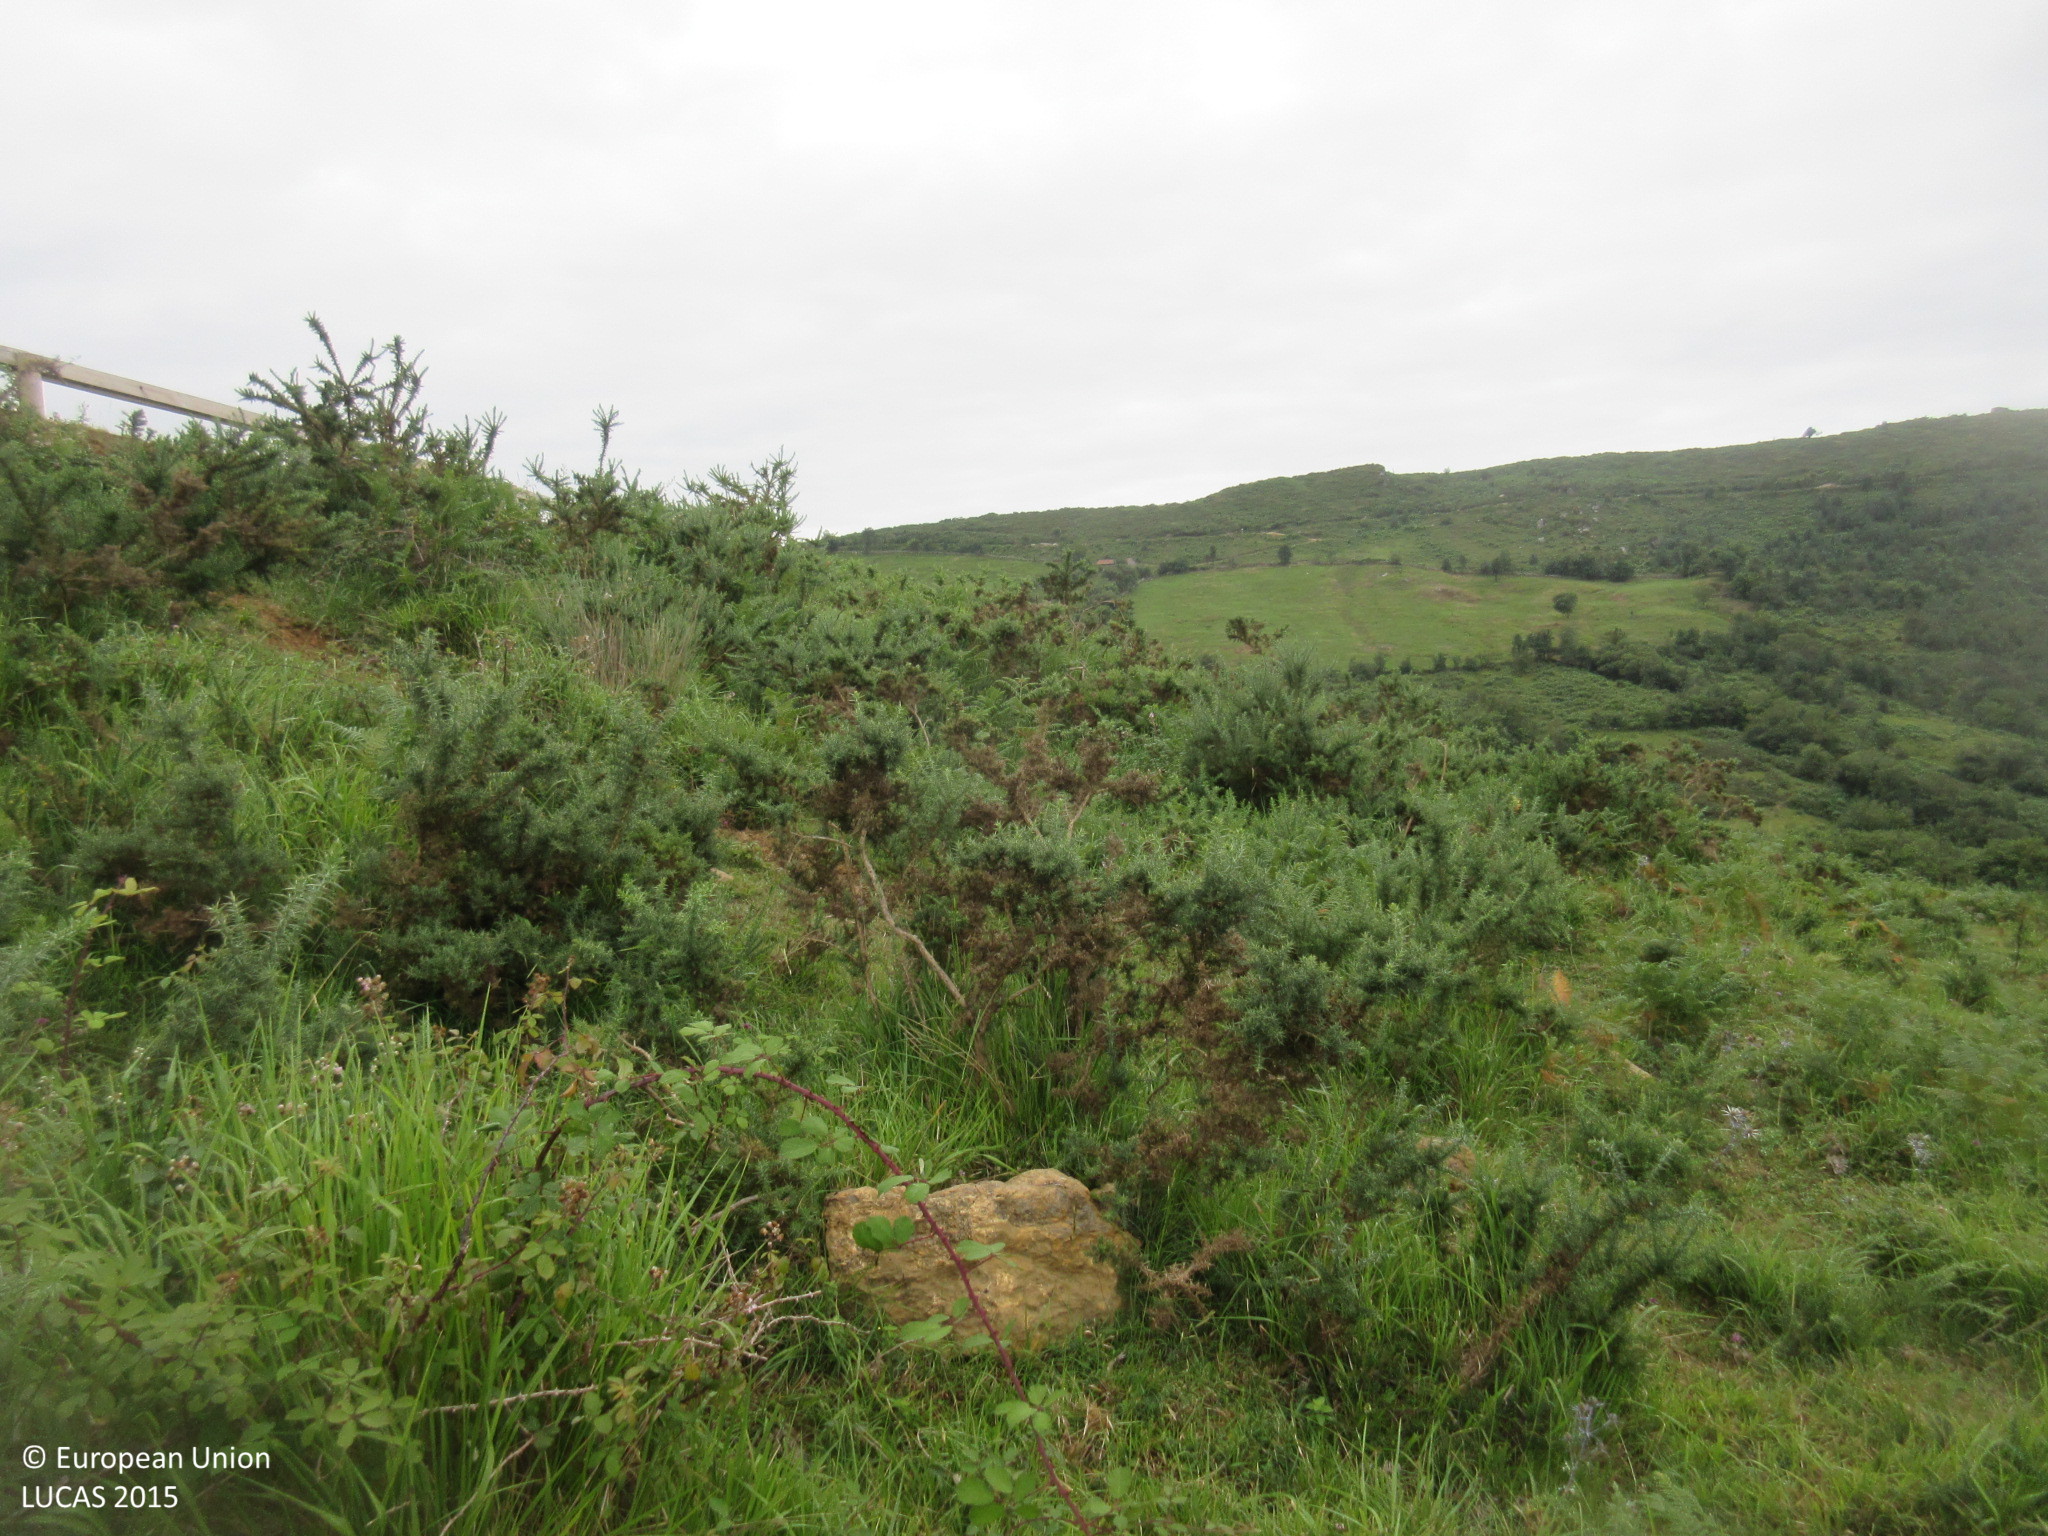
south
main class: Shrubland
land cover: Shrubland without tree cover
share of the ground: 50 - 75 %
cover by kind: shrubs 70 %, herbaceous plants 30 %
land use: Agriculture (excluding fallow land and kitchen gardens)
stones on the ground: < 10 %
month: July
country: ES
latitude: 43.3007
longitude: -4.4191
